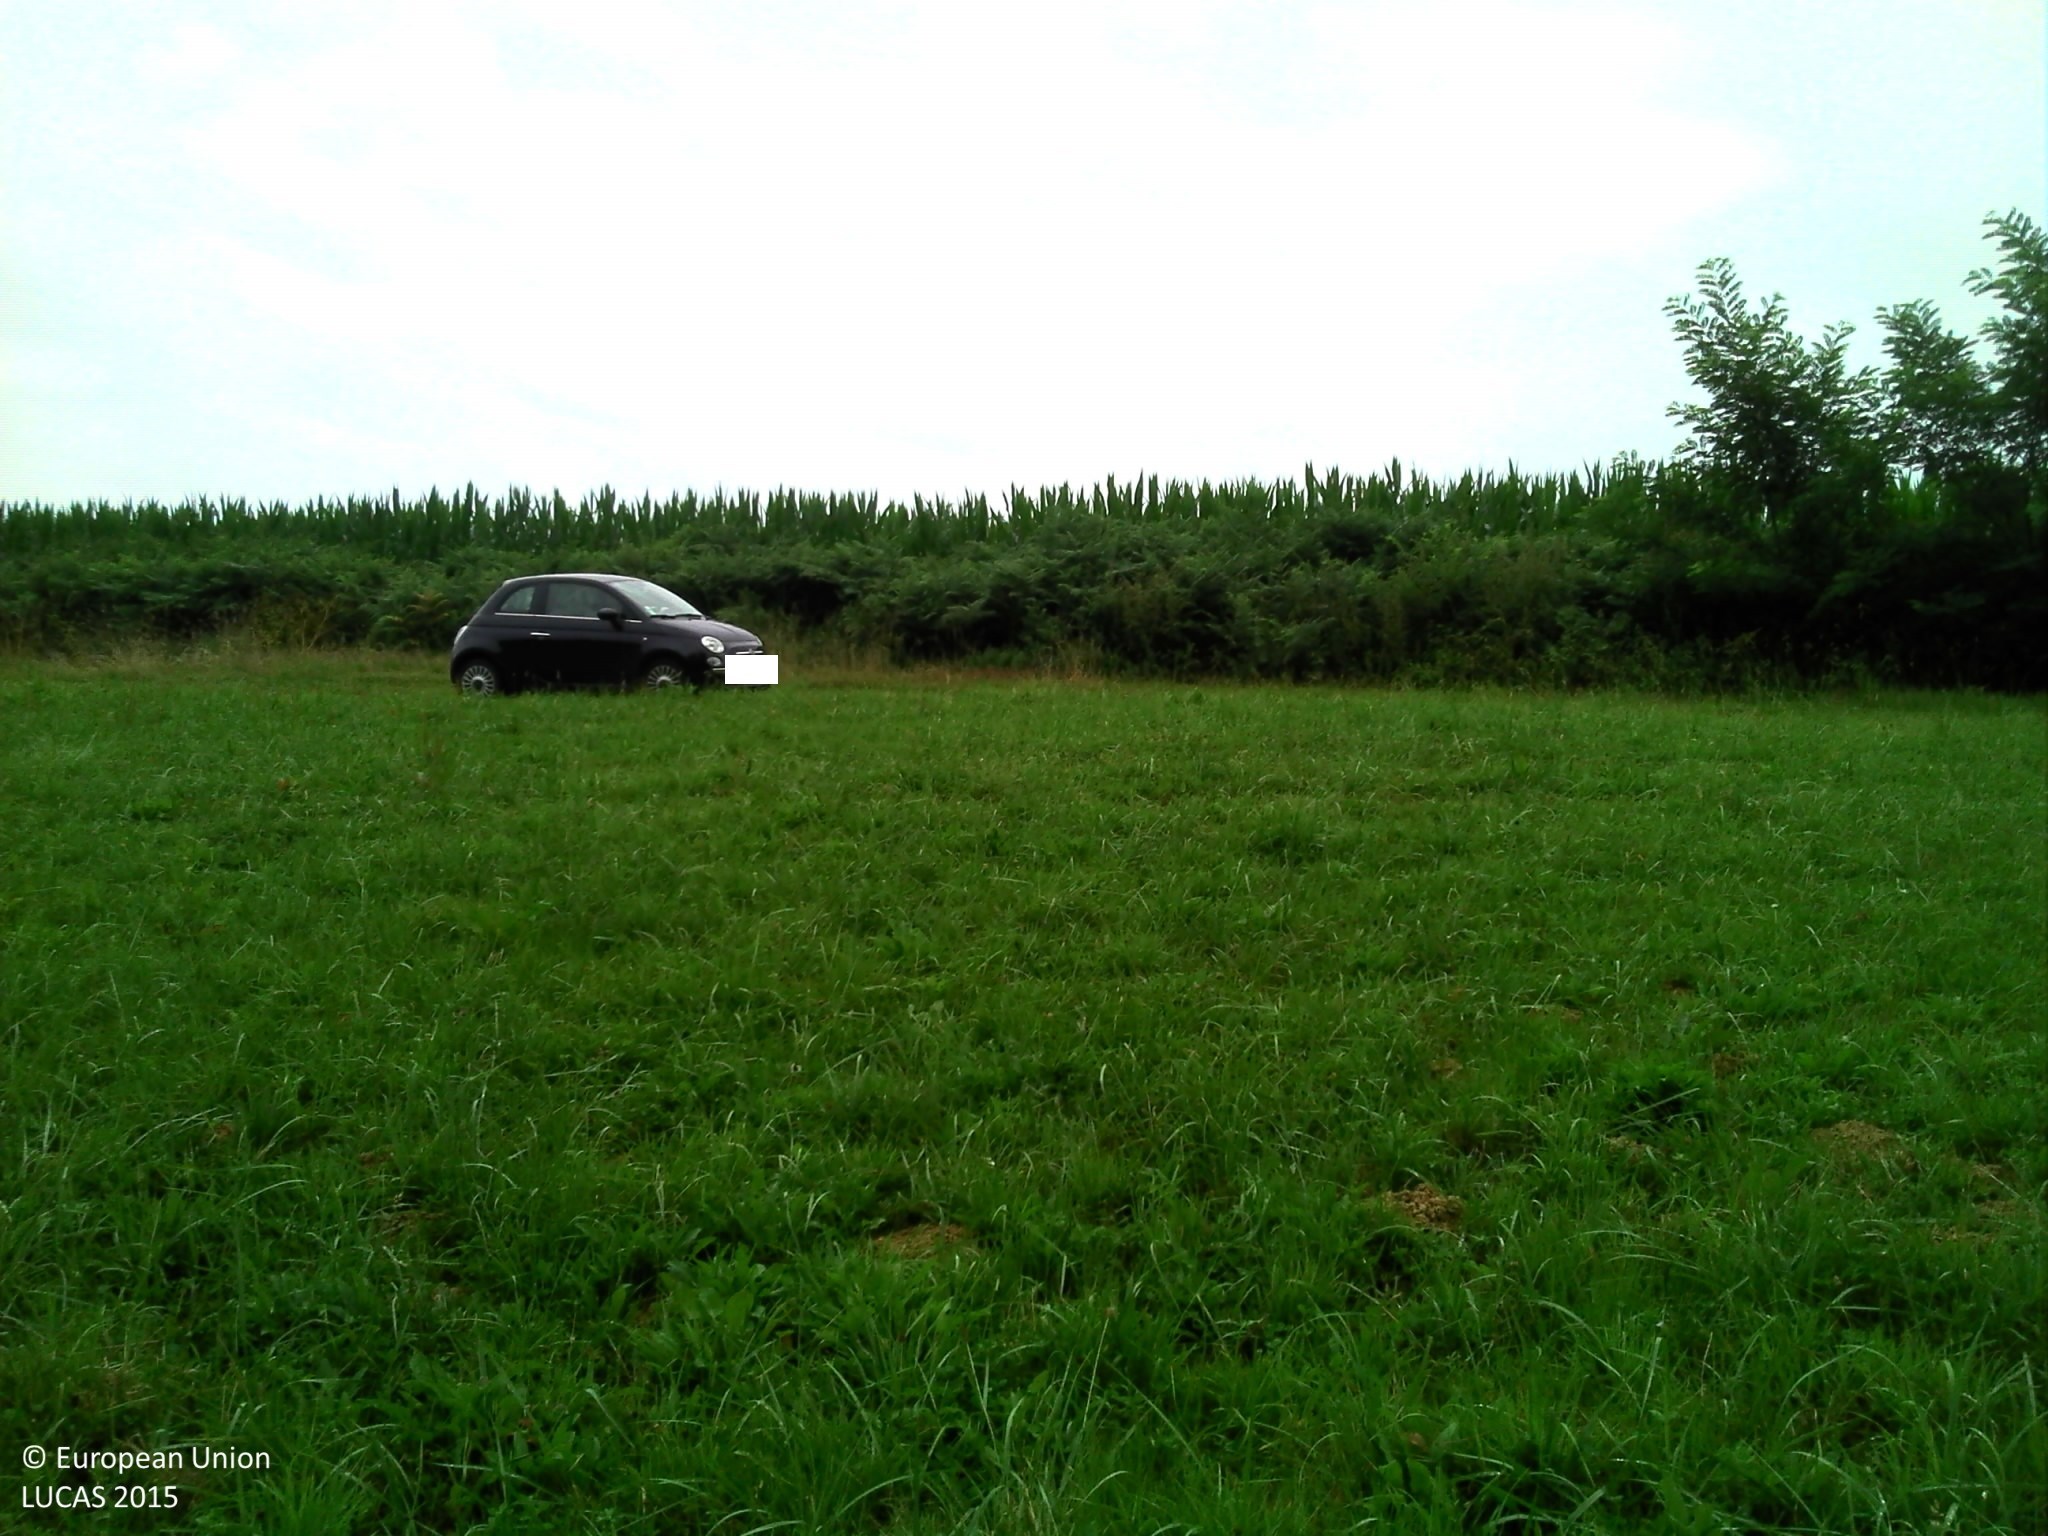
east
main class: Grassland
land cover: Grassland without tree/shrub cover
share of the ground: > 75 %
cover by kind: herbaceous plants 100 %
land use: Agriculture (excluding fallow land and kitchen gardens)
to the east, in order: Grassland without tree/shrub cover; Abandoned hedges; Maize; Abandoned hedges; Ditches and canals; Grass margins; Paved roads, cycling and walking lanes; Grass margins; Electric lines; Ditches and canals; Maize
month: July
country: FR
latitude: 43.5759
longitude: -1.2230
